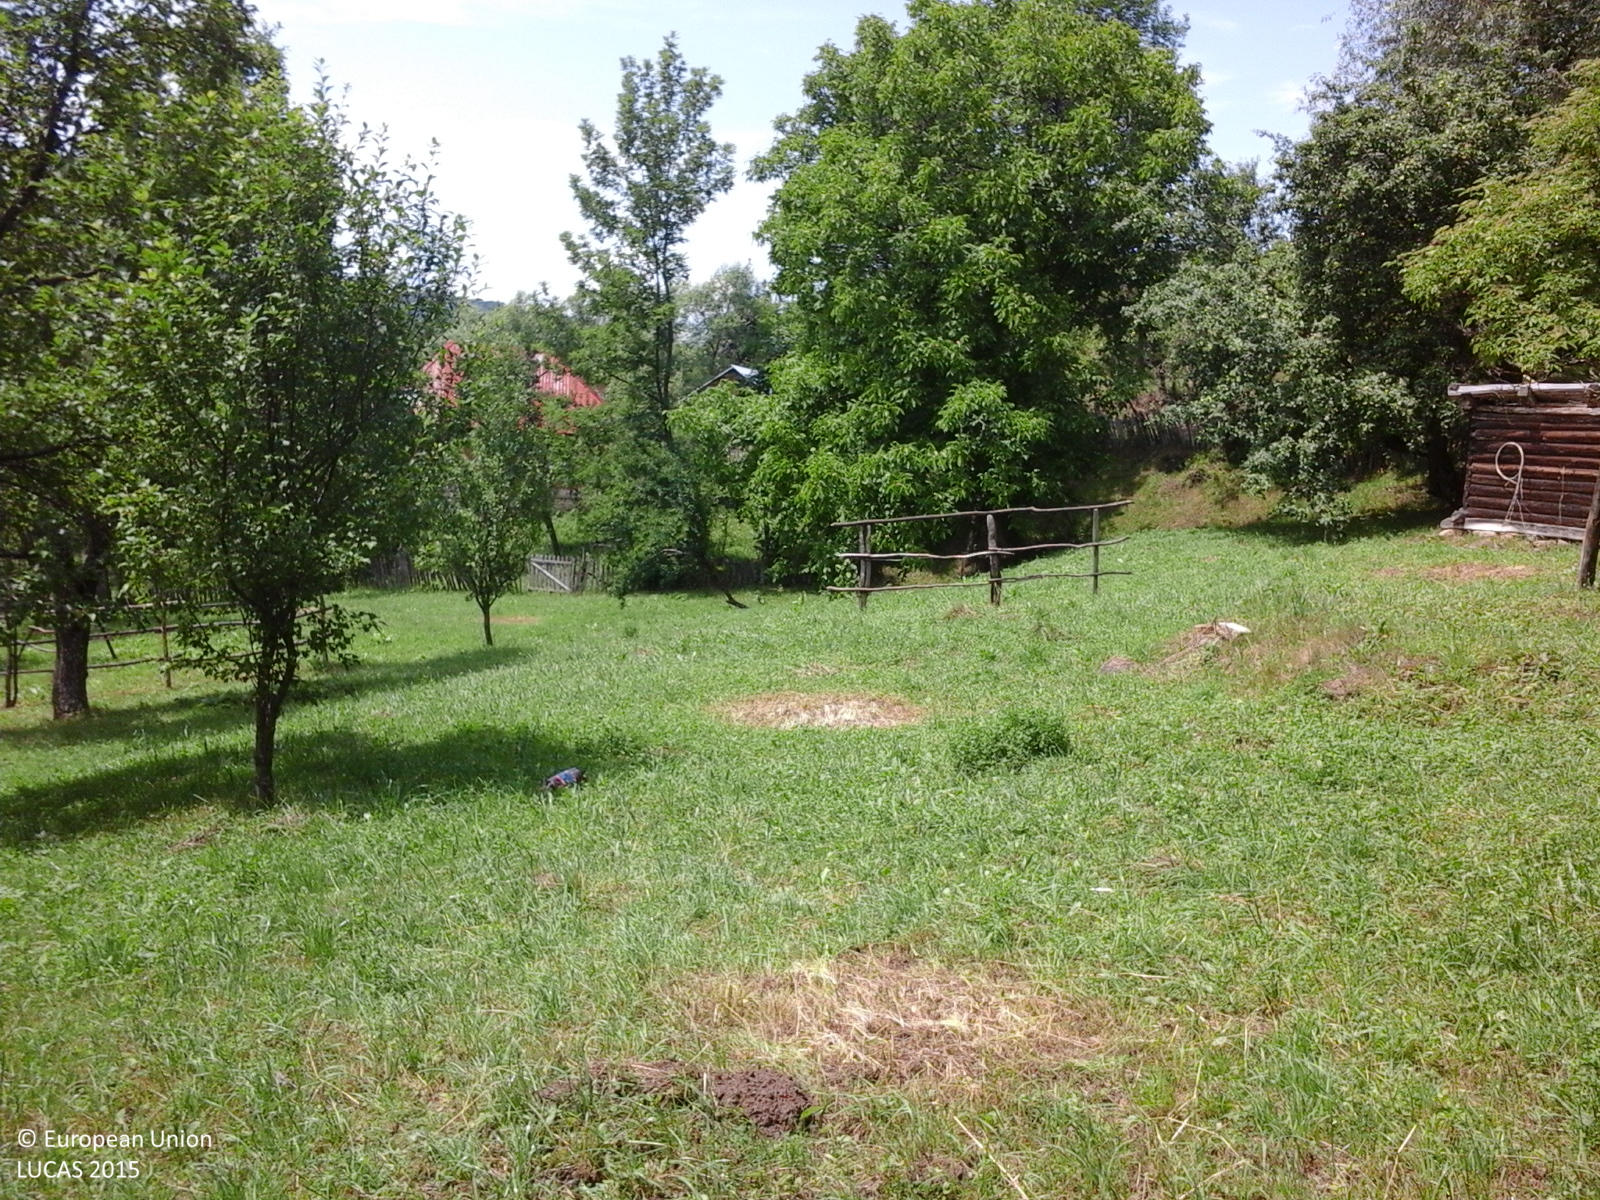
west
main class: Cropland
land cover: Apple fruit
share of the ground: > 75 %
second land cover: Grassland without tree/shrub cover
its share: > 75 %
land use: Agriculture (excluding fallow land and kitchen gardens)
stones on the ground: < 10 %
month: July
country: RO
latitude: 45.3405
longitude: 24.6161
